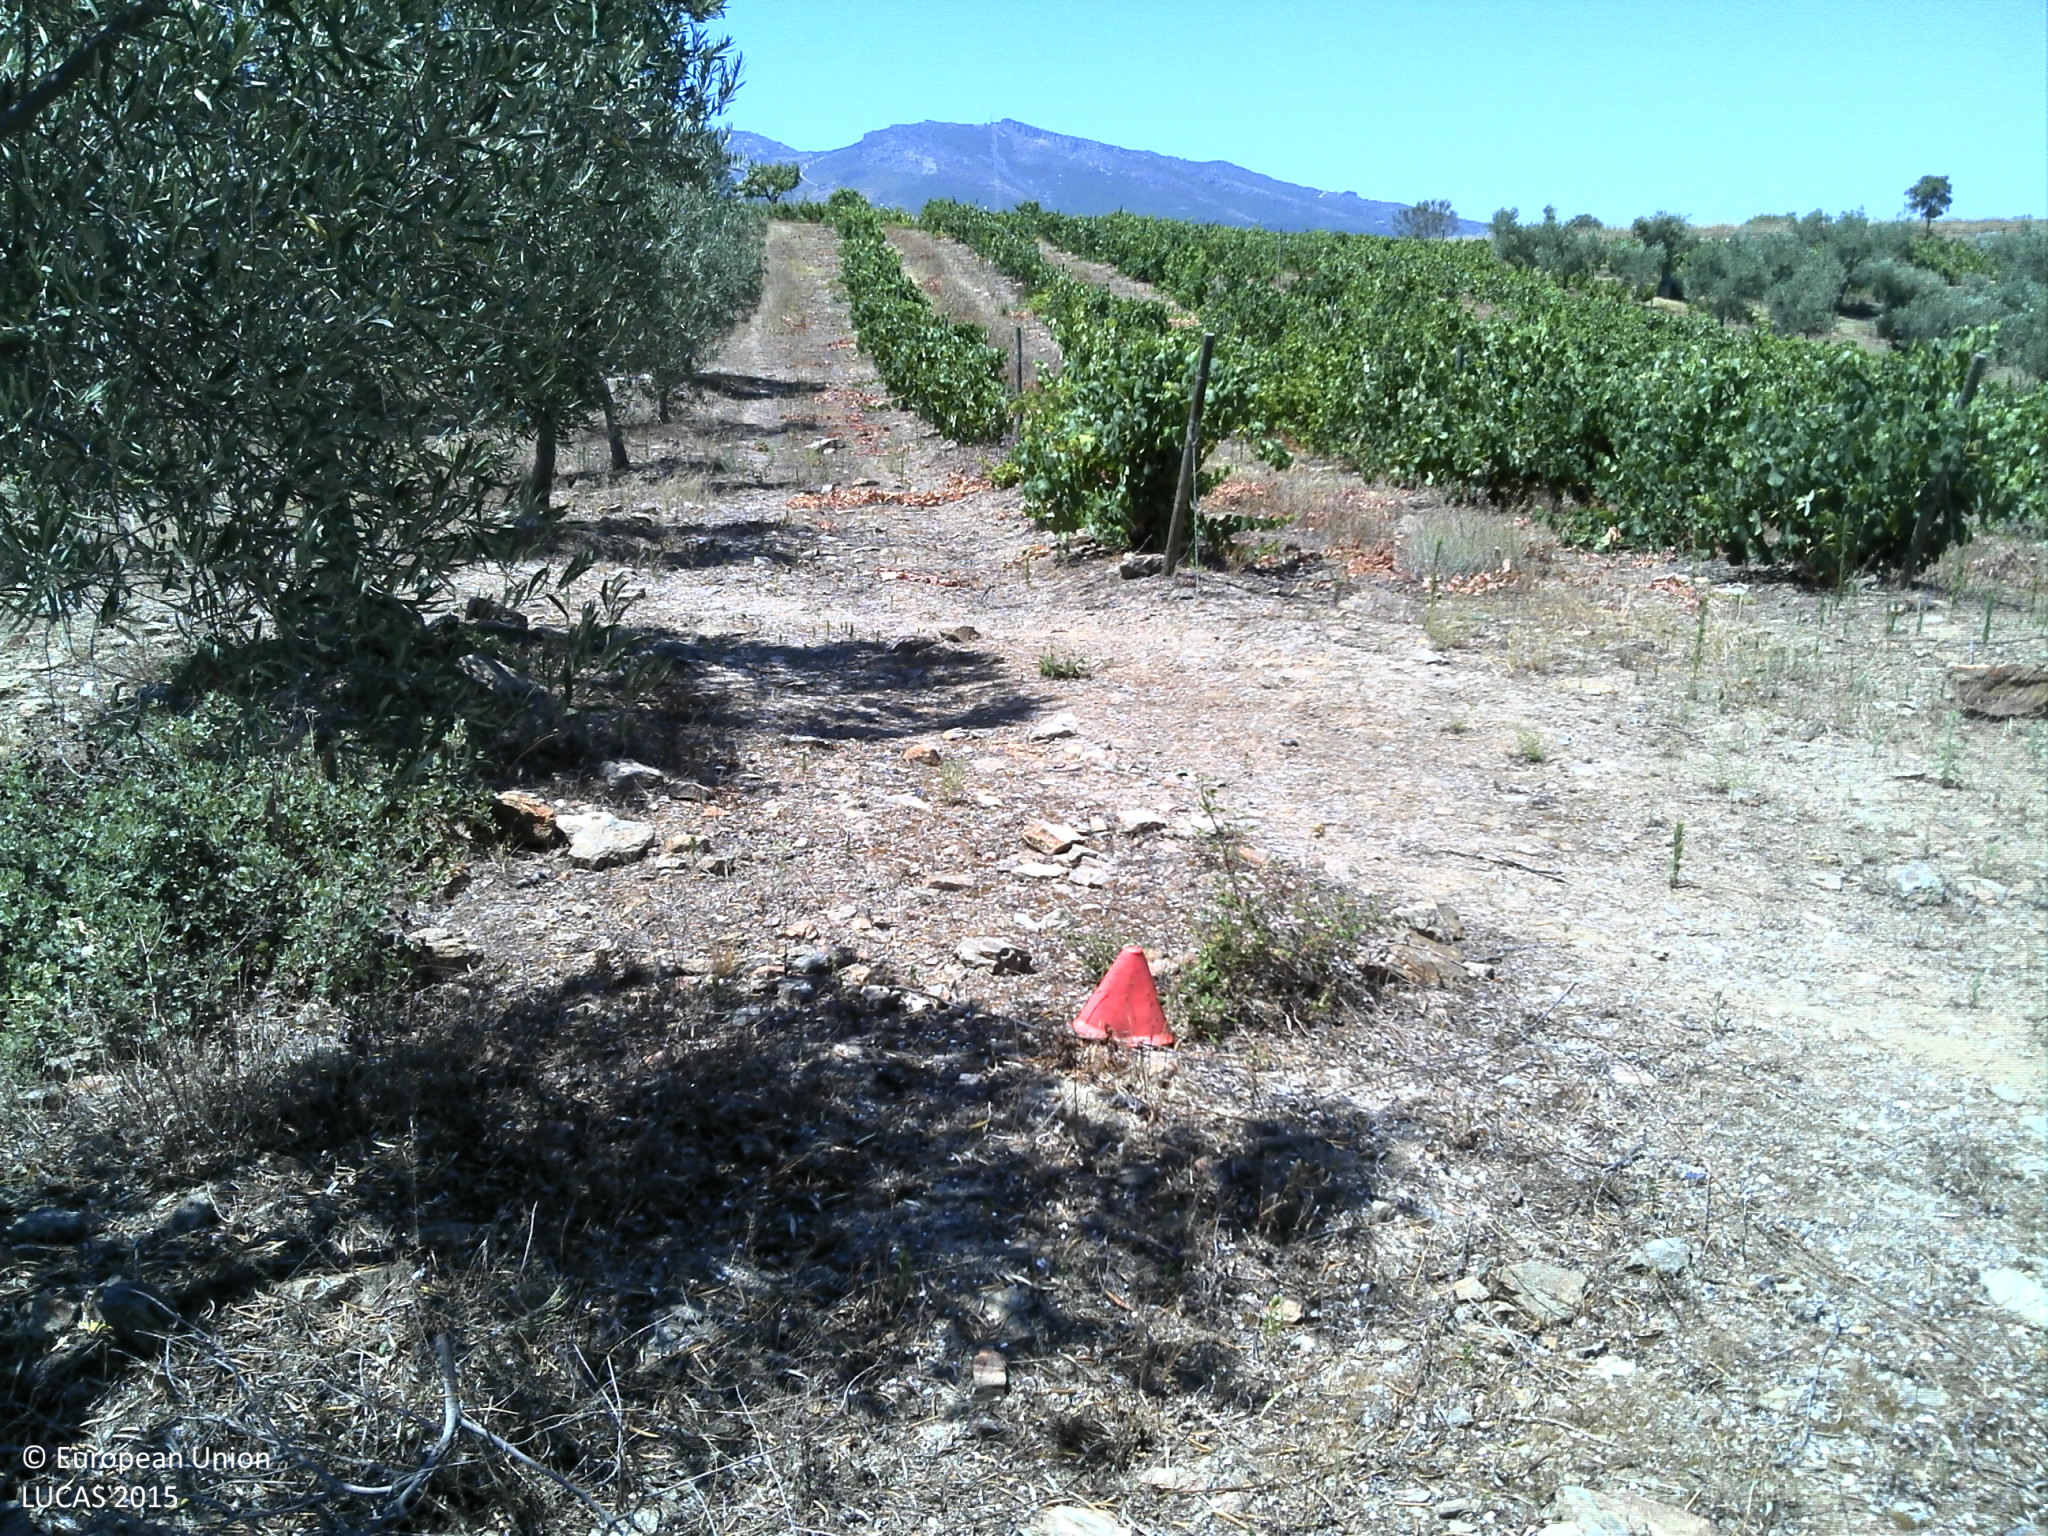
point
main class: Cropland
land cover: Olive groves
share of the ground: 25 - 50 %
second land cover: Grassland without tree/shrub cover
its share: 10 - 25 %
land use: Agriculture (excluding fallow land and kitchen gardens)
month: July
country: PT
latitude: 41.4204
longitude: -7.2410
